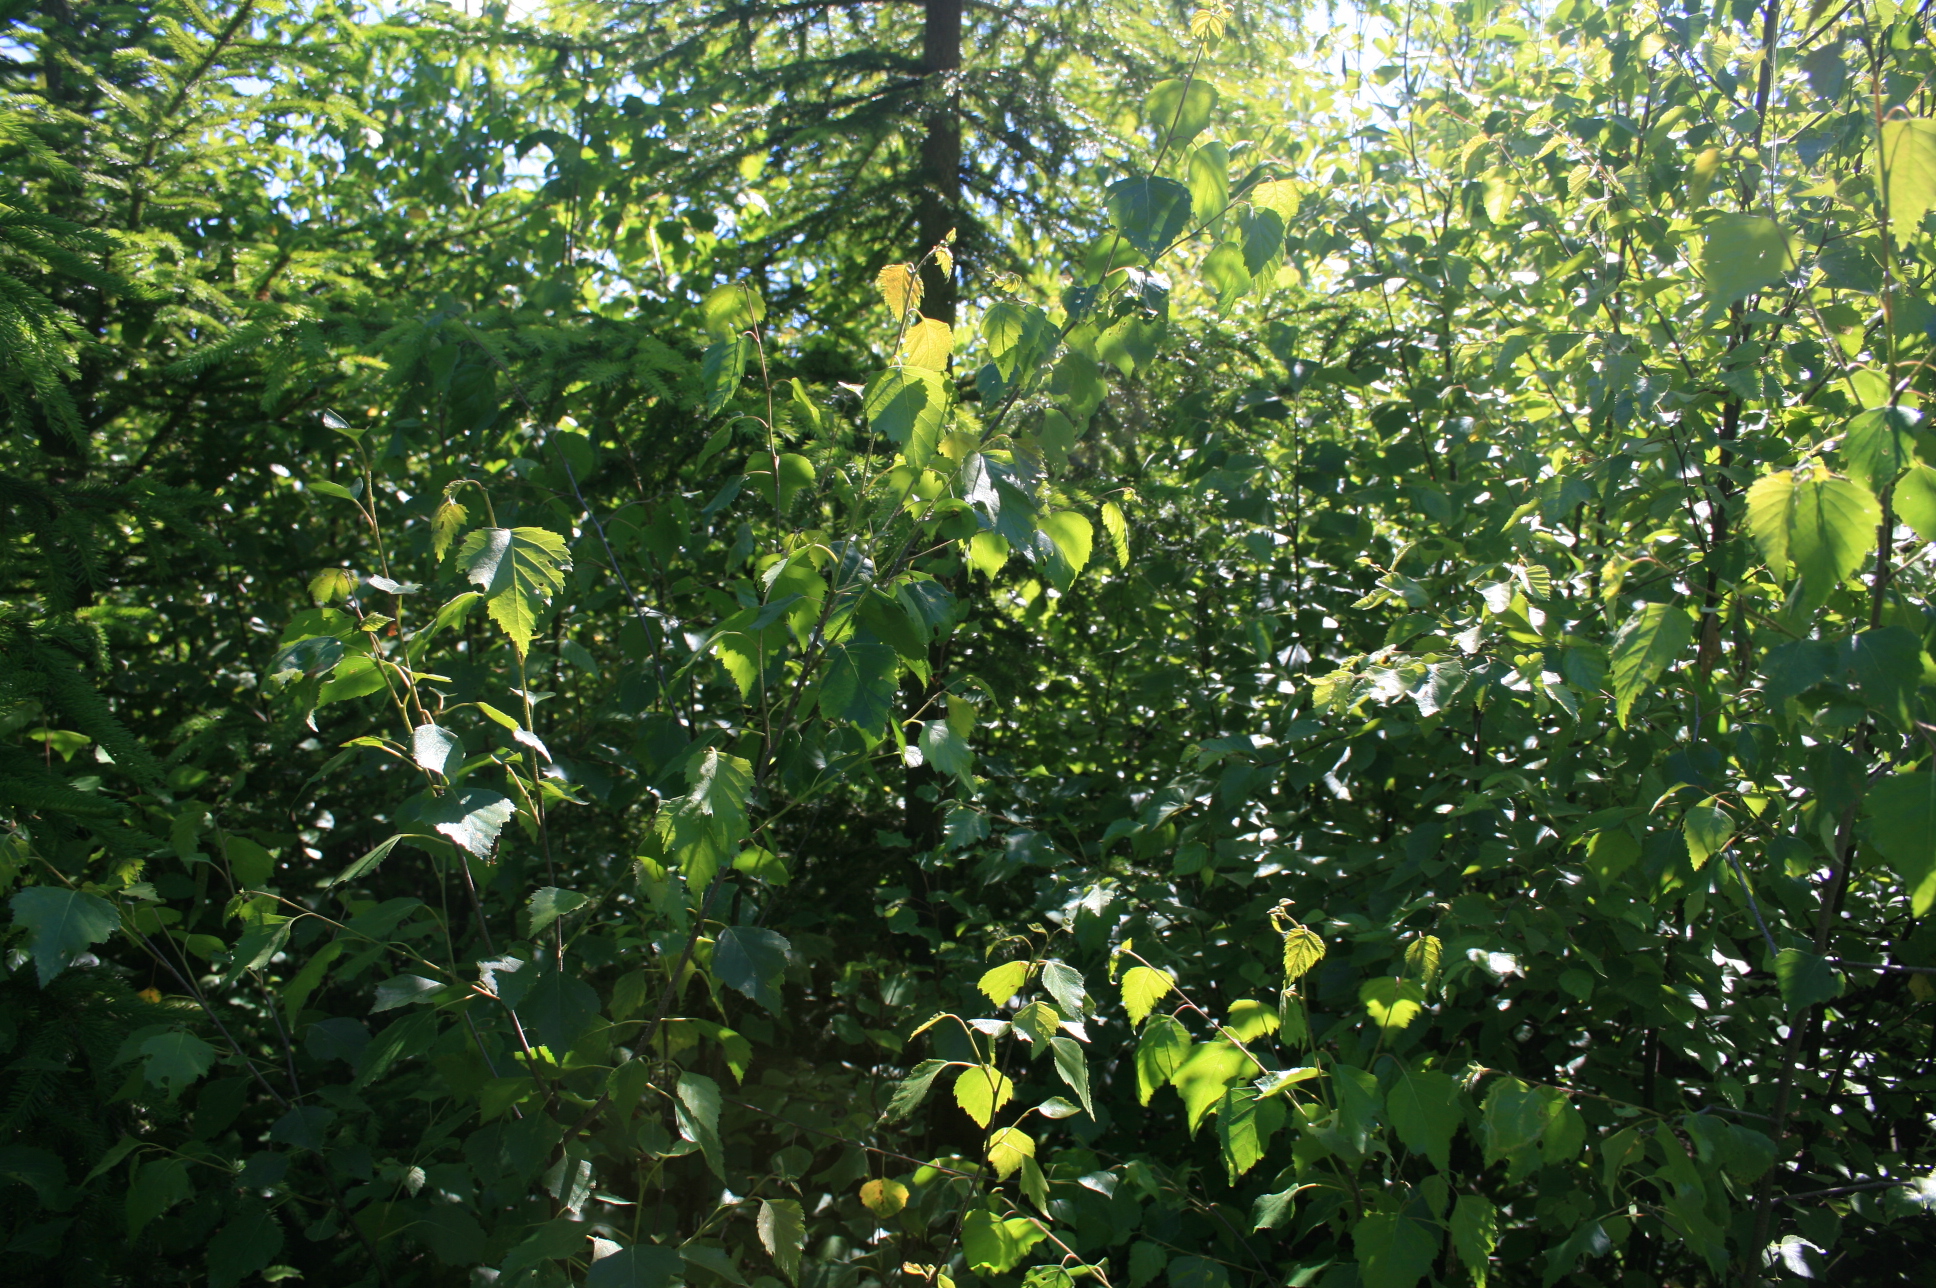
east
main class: Woodland
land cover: Spruce dominated mixed woodland
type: hemiboreal forest and nemoral coniferous forest and mixed broadleaved-coniferous forest
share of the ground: > 75 %
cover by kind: broadleaved forest trees 55 %, coniferous forest trees 45 %
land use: Forestry
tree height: < 5 m
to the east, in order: Spruce dominated mixed woodland; Shruby margins; Tracks; Shruby margins; Broadleaved woodland; Ditches and canals; Abandoned hedges; Spontaneously vegetated surfaces; Grassland without tree/shrub cover
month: June
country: LT
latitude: 55.4441
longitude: 22.1489
